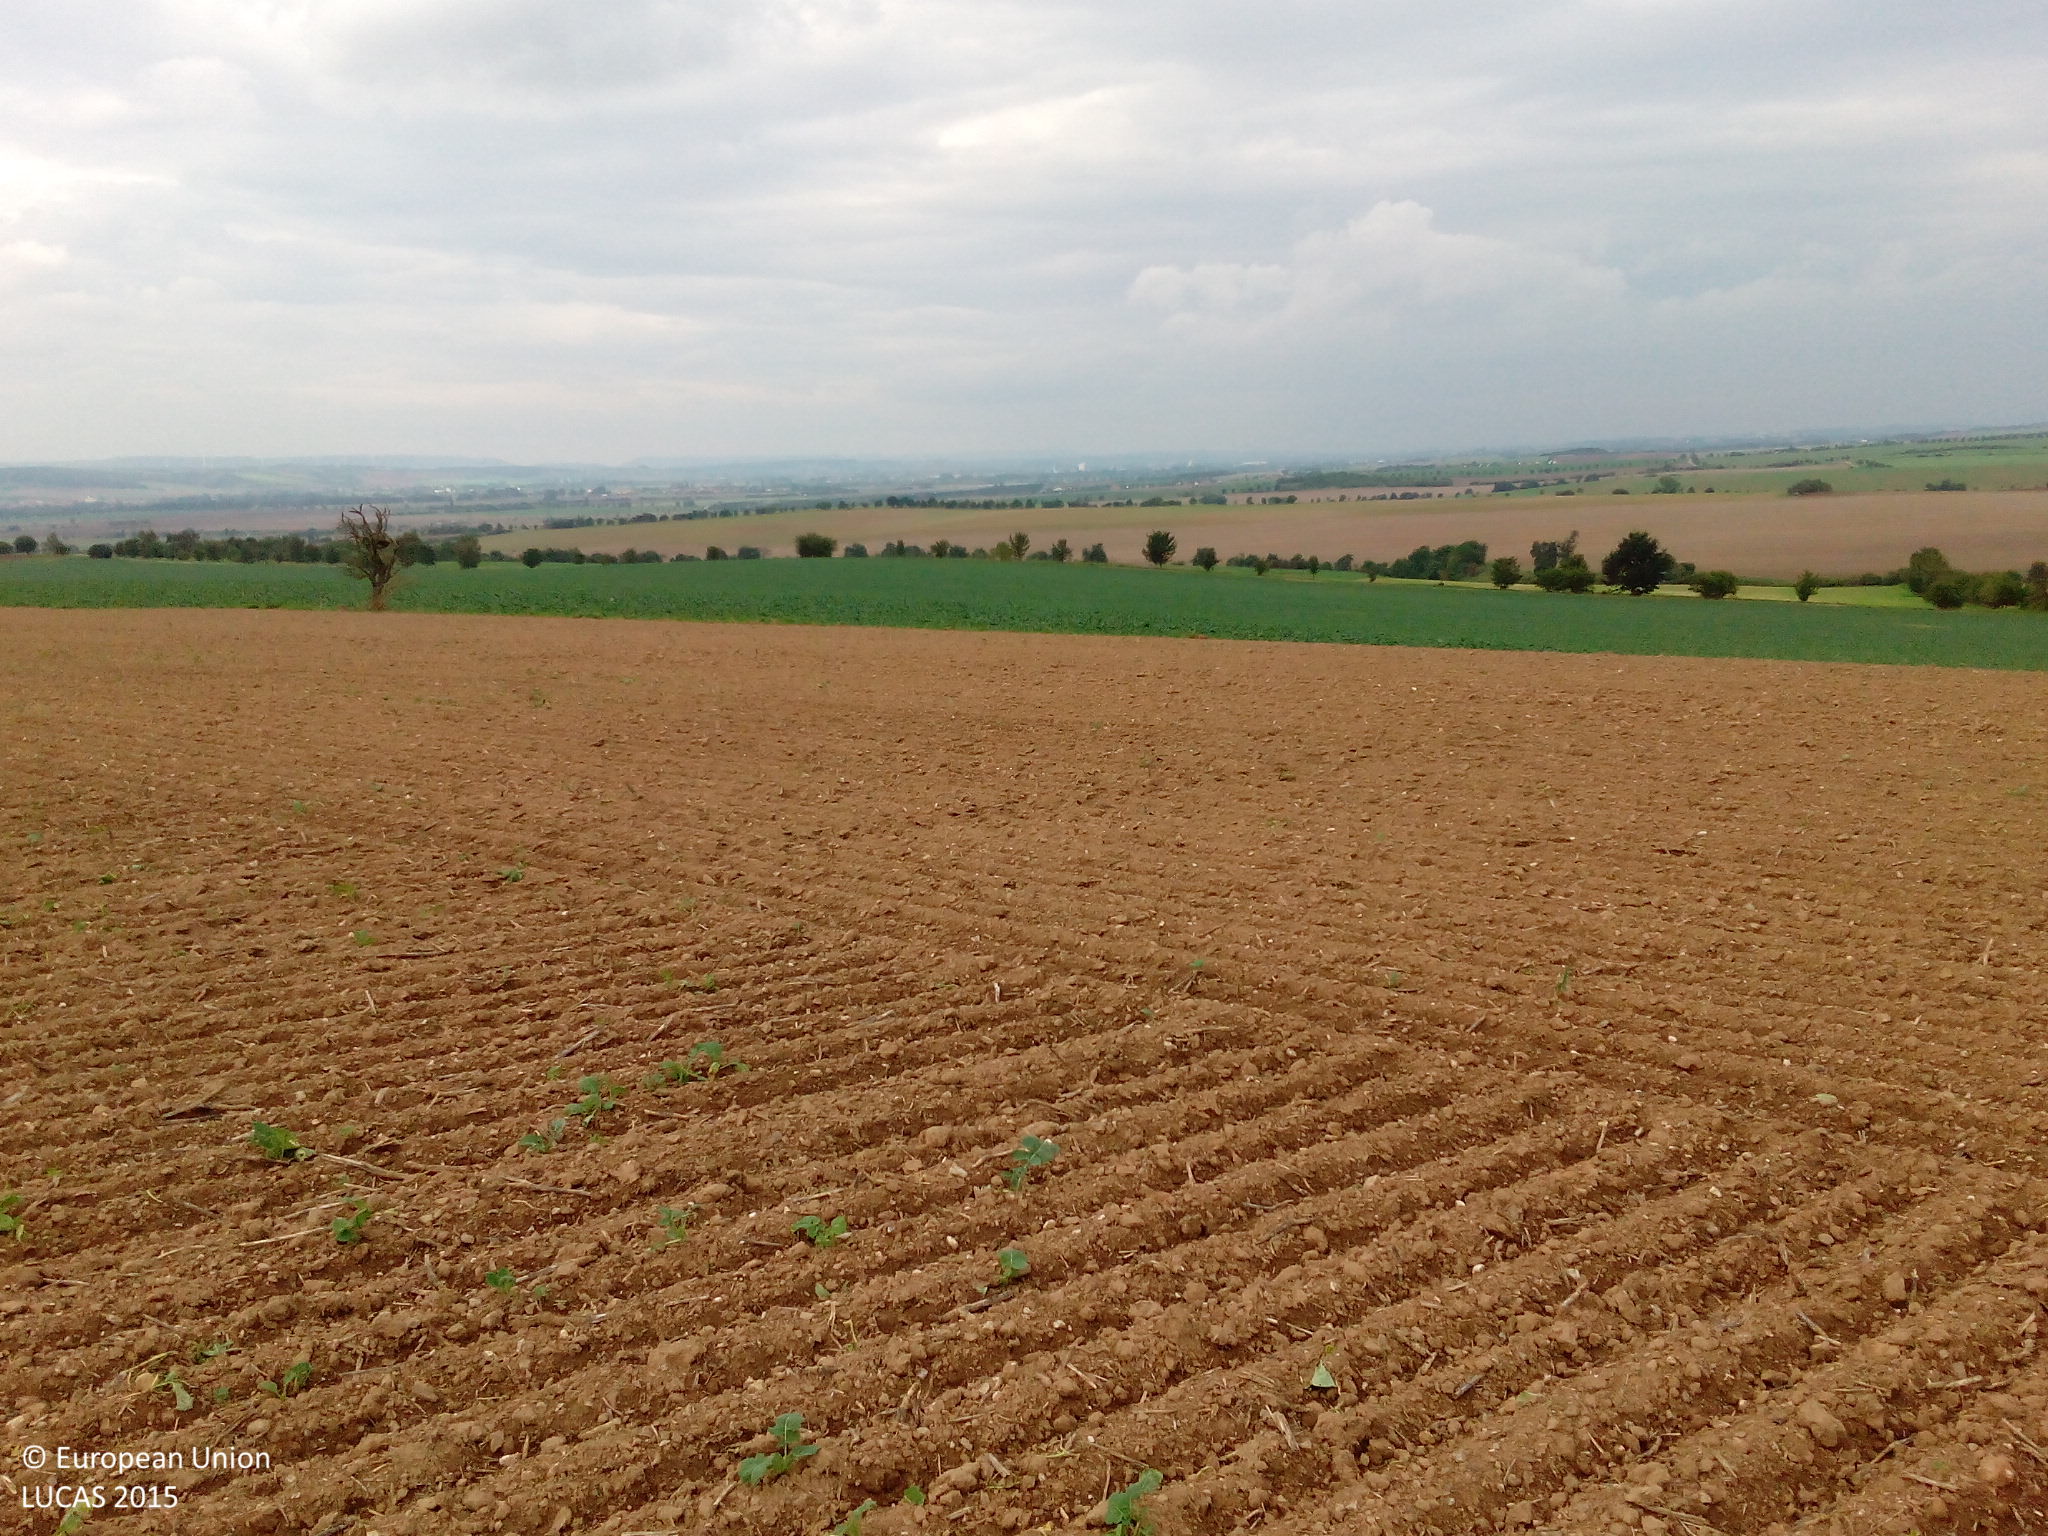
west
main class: Cropland
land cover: Rape and turnip rape
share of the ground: < 10 %
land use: Agriculture (excluding fallow land and kitchen gardens)
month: September
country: DE
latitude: 51.4747
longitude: 10.9643
